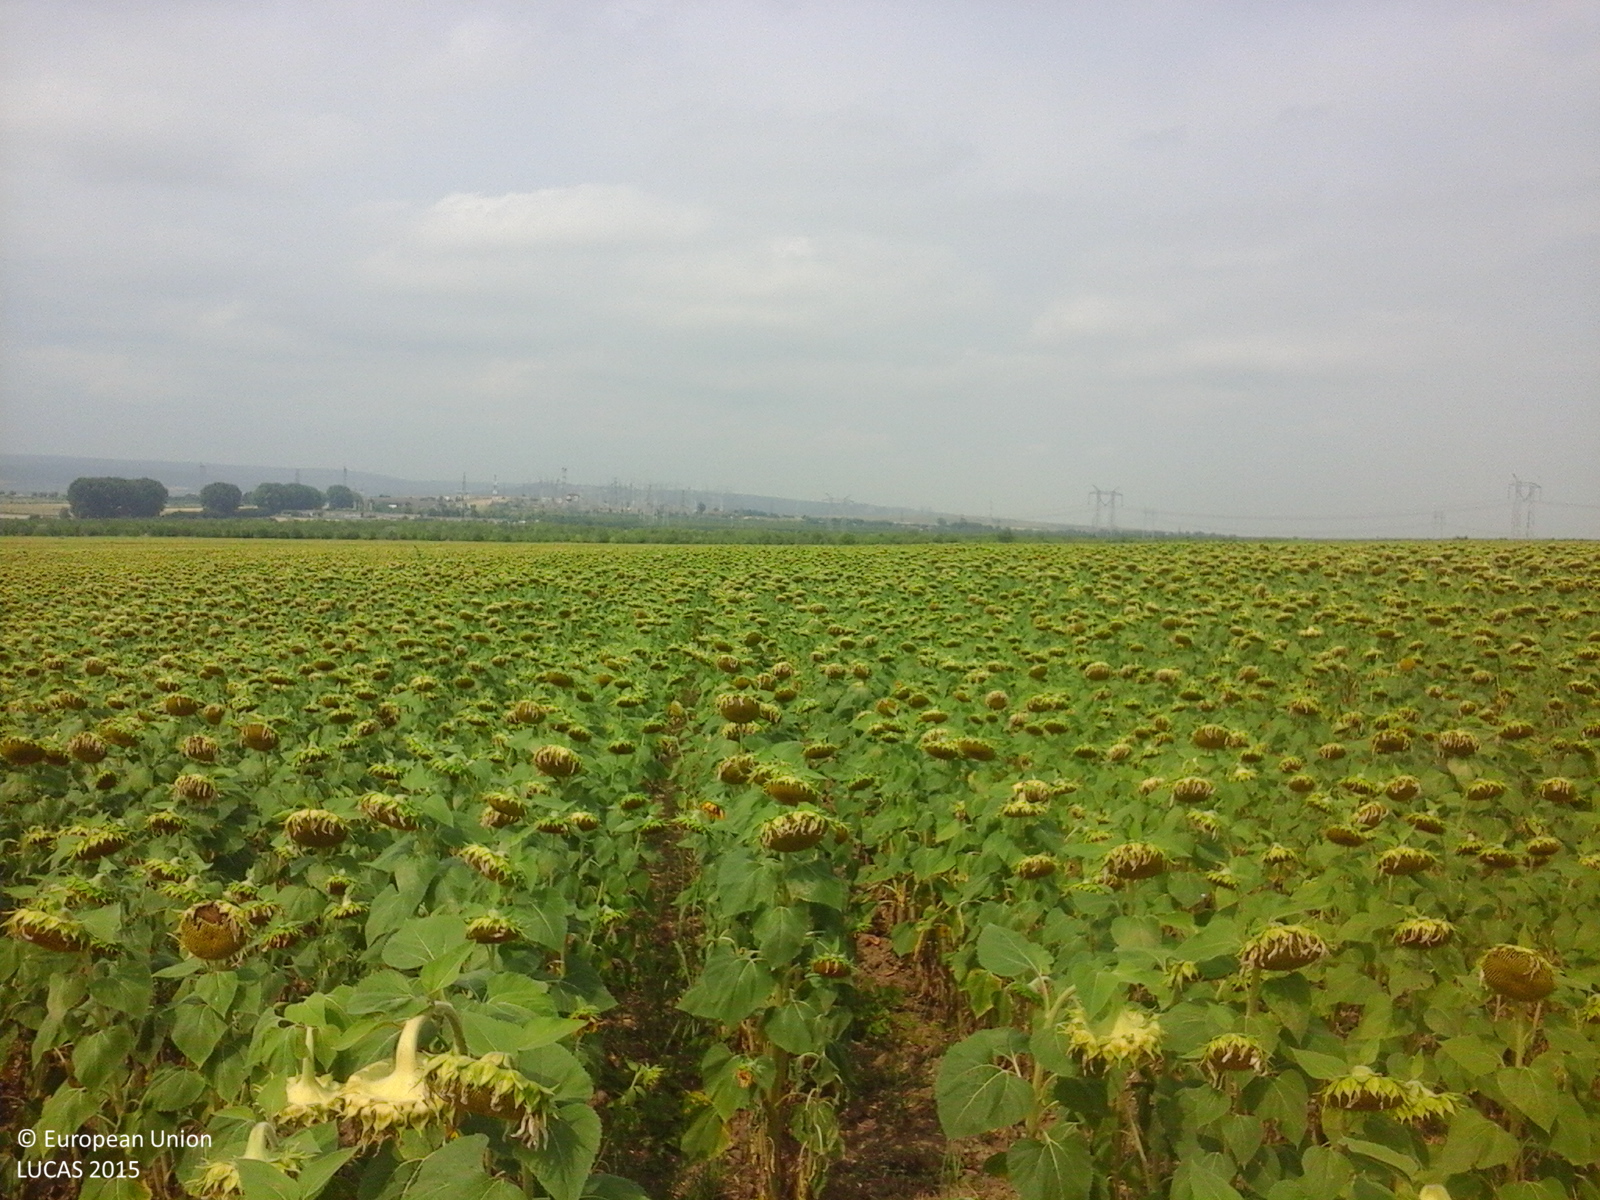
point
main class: Cropland
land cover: Sunflower
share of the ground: > 75 %
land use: Agriculture (excluding fallow land and kitchen gardens)
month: July
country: RO
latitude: 45.2555
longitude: 28.4934
